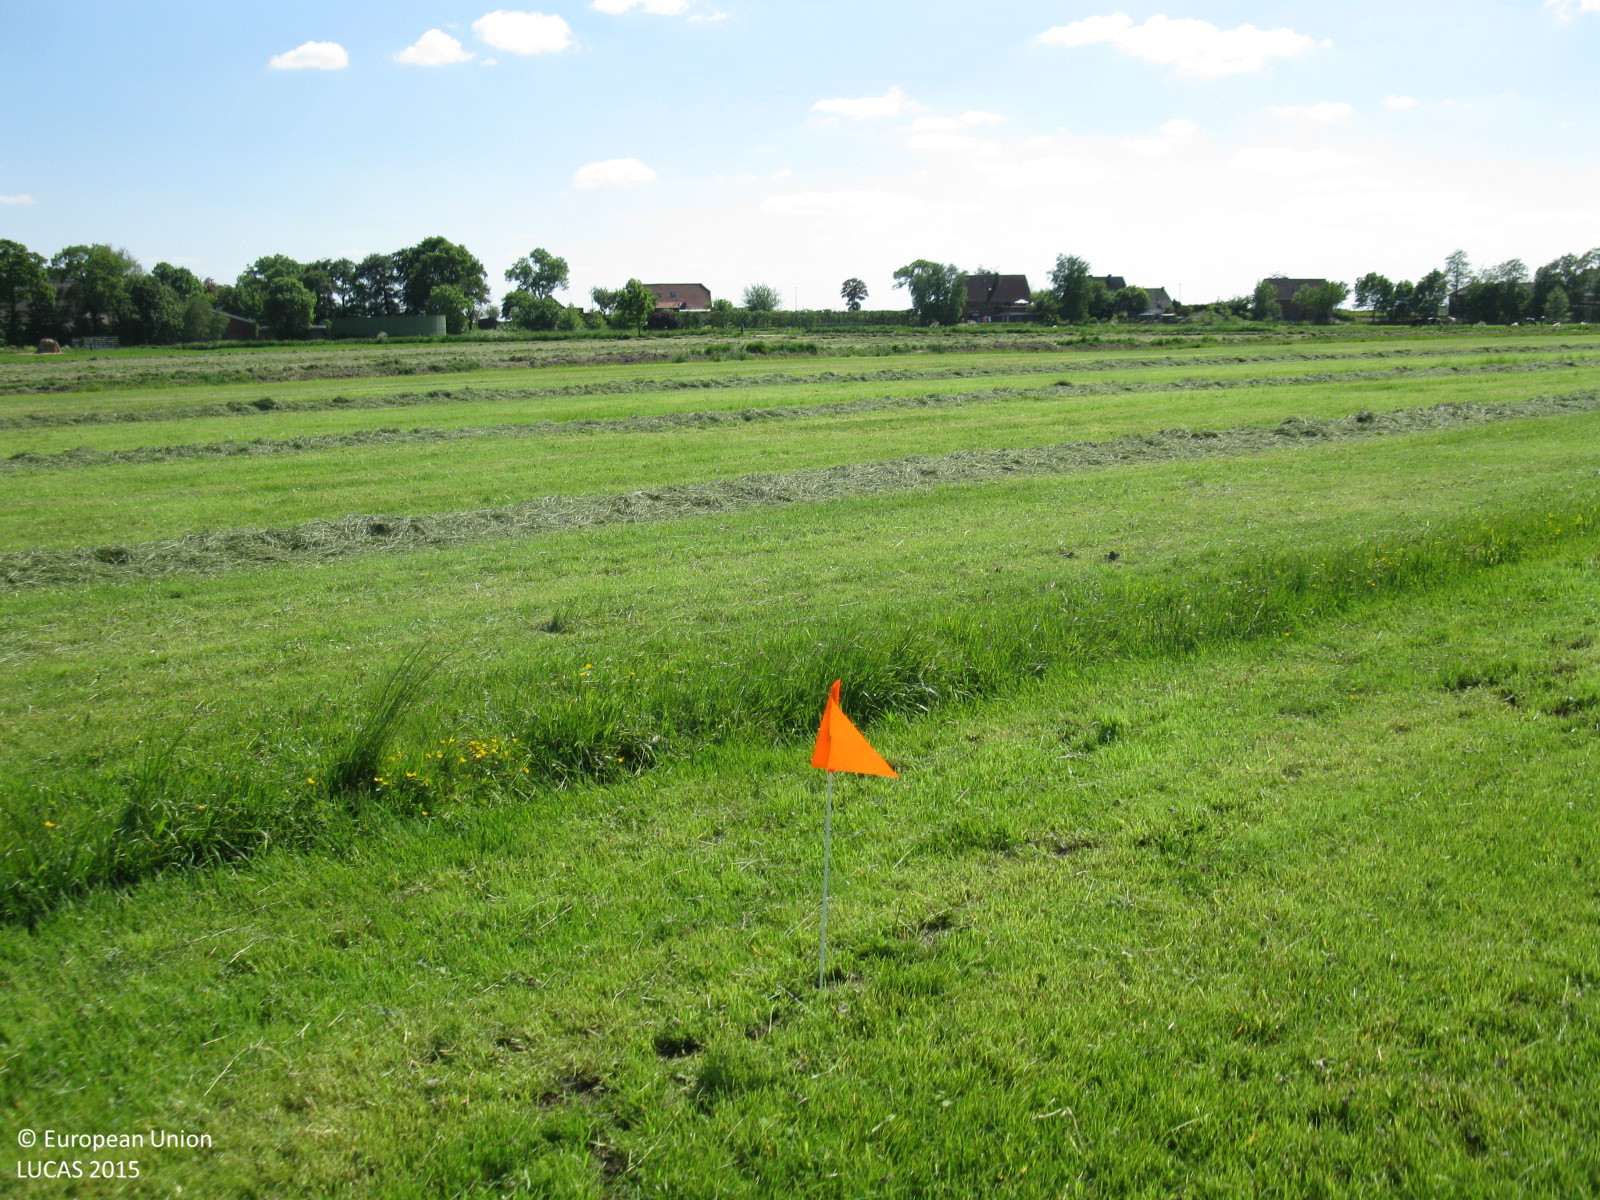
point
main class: Grassland
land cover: Grassland without tree/shrub cover
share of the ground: > 75 %
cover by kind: herbaceous plants 100 %
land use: Agriculture (excluding fallow land and kitchen gardens)
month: June
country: DE
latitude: 53.2457
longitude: 7.2881
